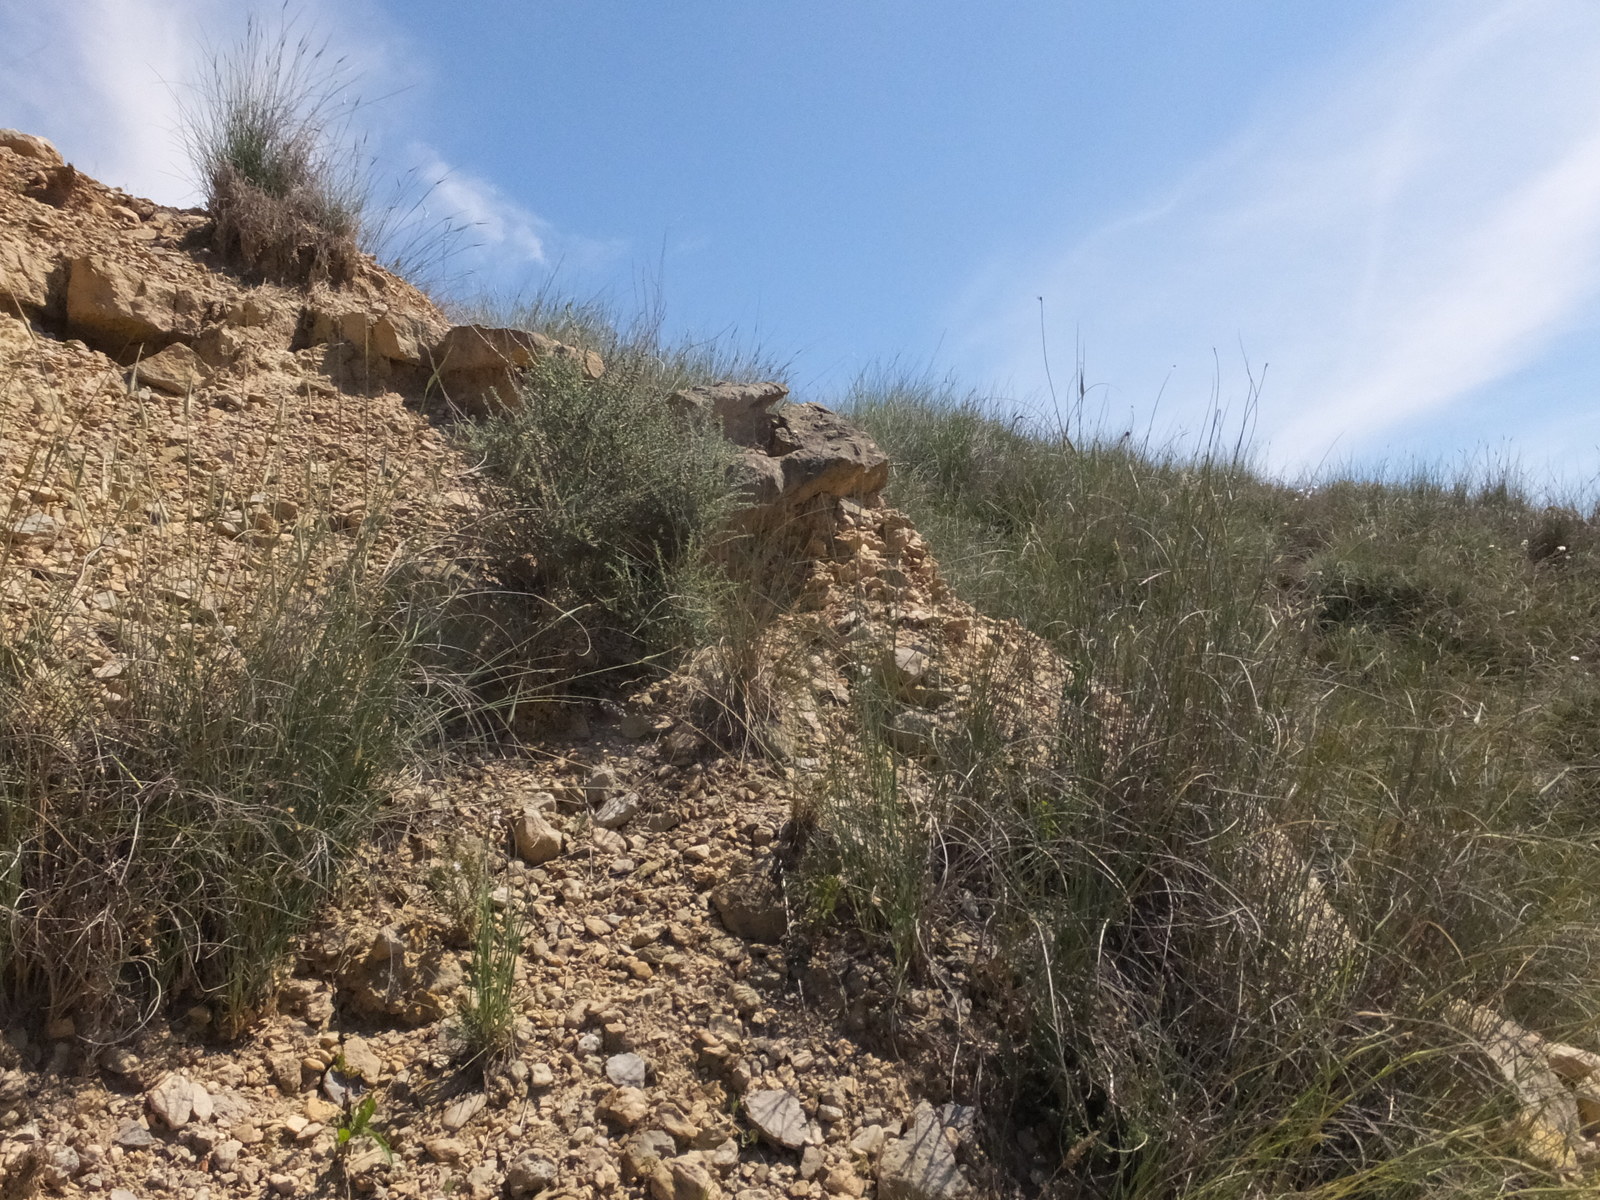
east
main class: Grassland
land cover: Grassland without tree/shrub cover
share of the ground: 50 - 75 %
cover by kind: herbaceous plants 65 %, unconsolidated bare surface 30 %, shrubs 5 %
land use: Semi-natural and natural areas not in use
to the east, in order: Grassland without tree/shrub cover; Rocks and stones; Grassland without tree/shrub cover
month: April
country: ES
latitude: 41.7398
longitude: -0.1779
